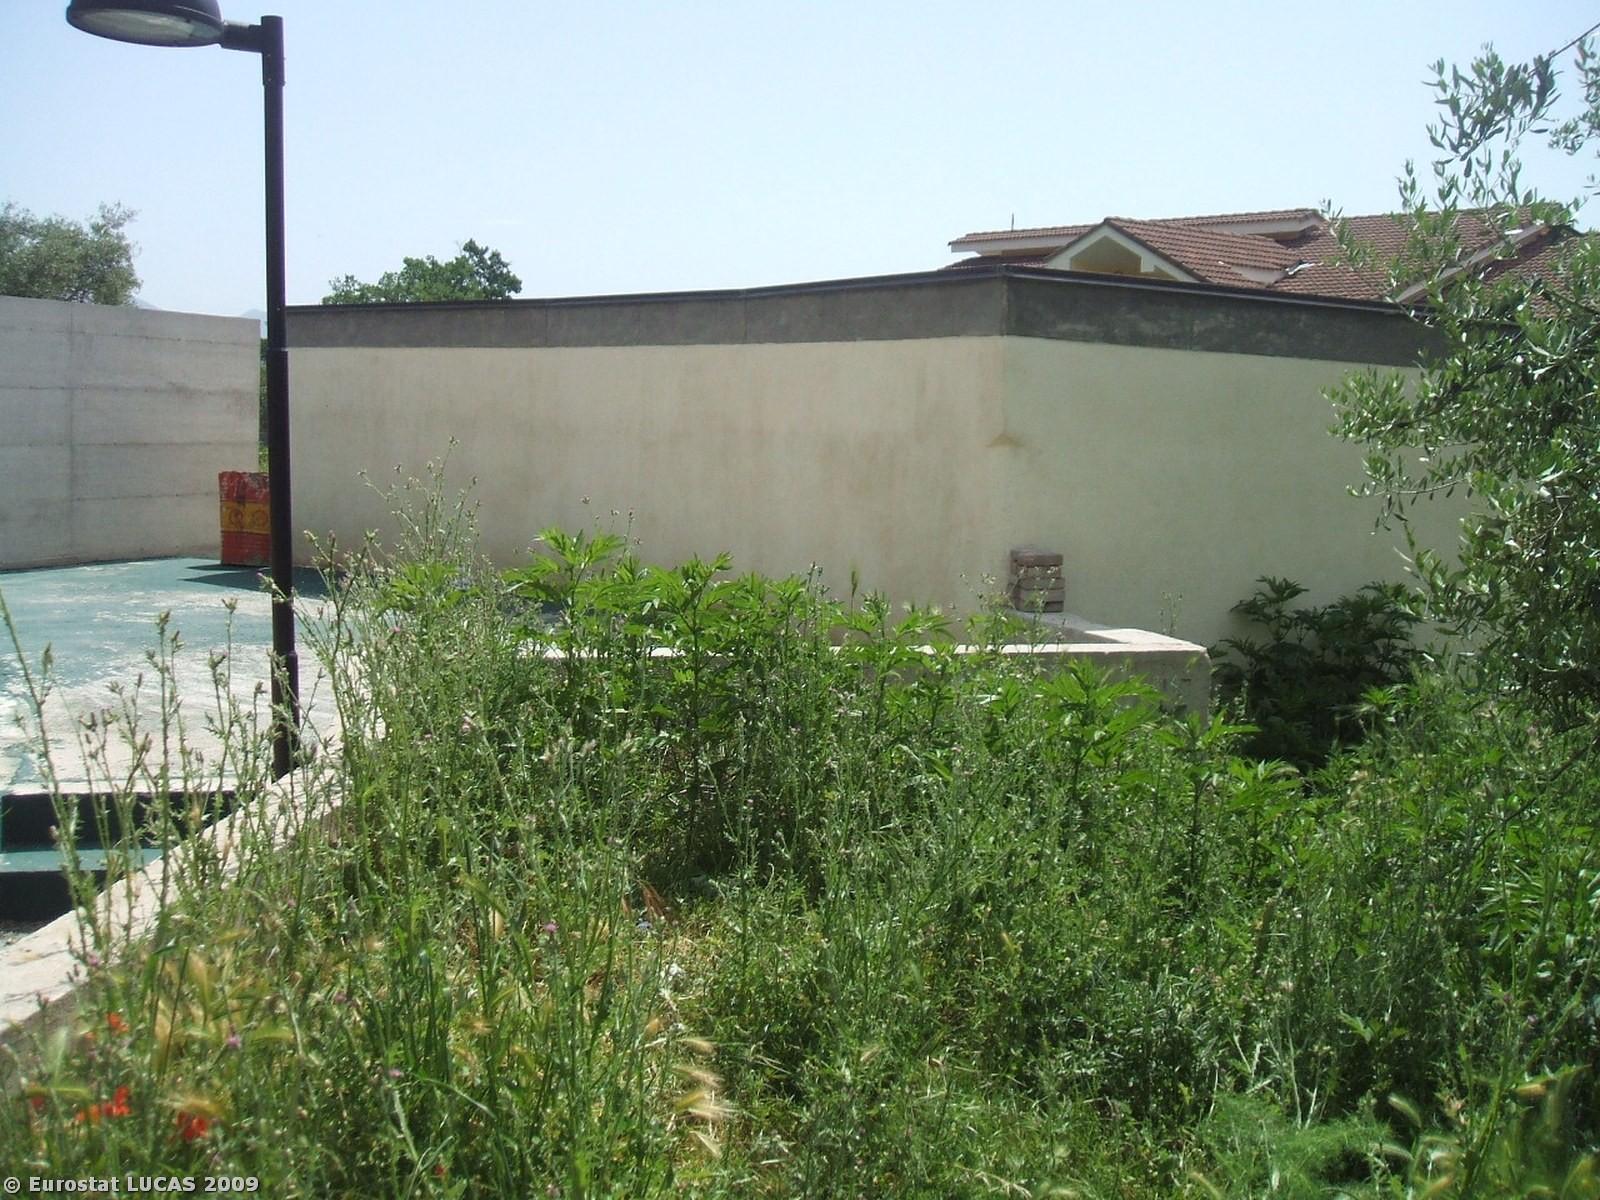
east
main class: Cropland
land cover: Olive groves
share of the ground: 25 - 50 %
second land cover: Spontaneously vegetated surfaces
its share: > 75 %
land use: Agriculture (excluding fallow land and kitchen gardens)
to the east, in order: Olive groves; Spontaneously vegetated surfaces; Artificial constructions in urban areas; Fences; Olive groves; Fences; Paved roads, cycling and walking lanes; Fences; Grassland without tree/shrub cover; Olive groves; Abandoned hedges; Mixed cereals for fodder; Olive groves; Electric lines; Shrubland with sparse tree cover; Grass margins; Paved roads, cycling and walking lanes; Fences; Spontaneously vegetated surfaces; Lines of trees; Artificial constructions in urban areas
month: May
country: IT
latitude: 40.3462
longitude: 15.5453
